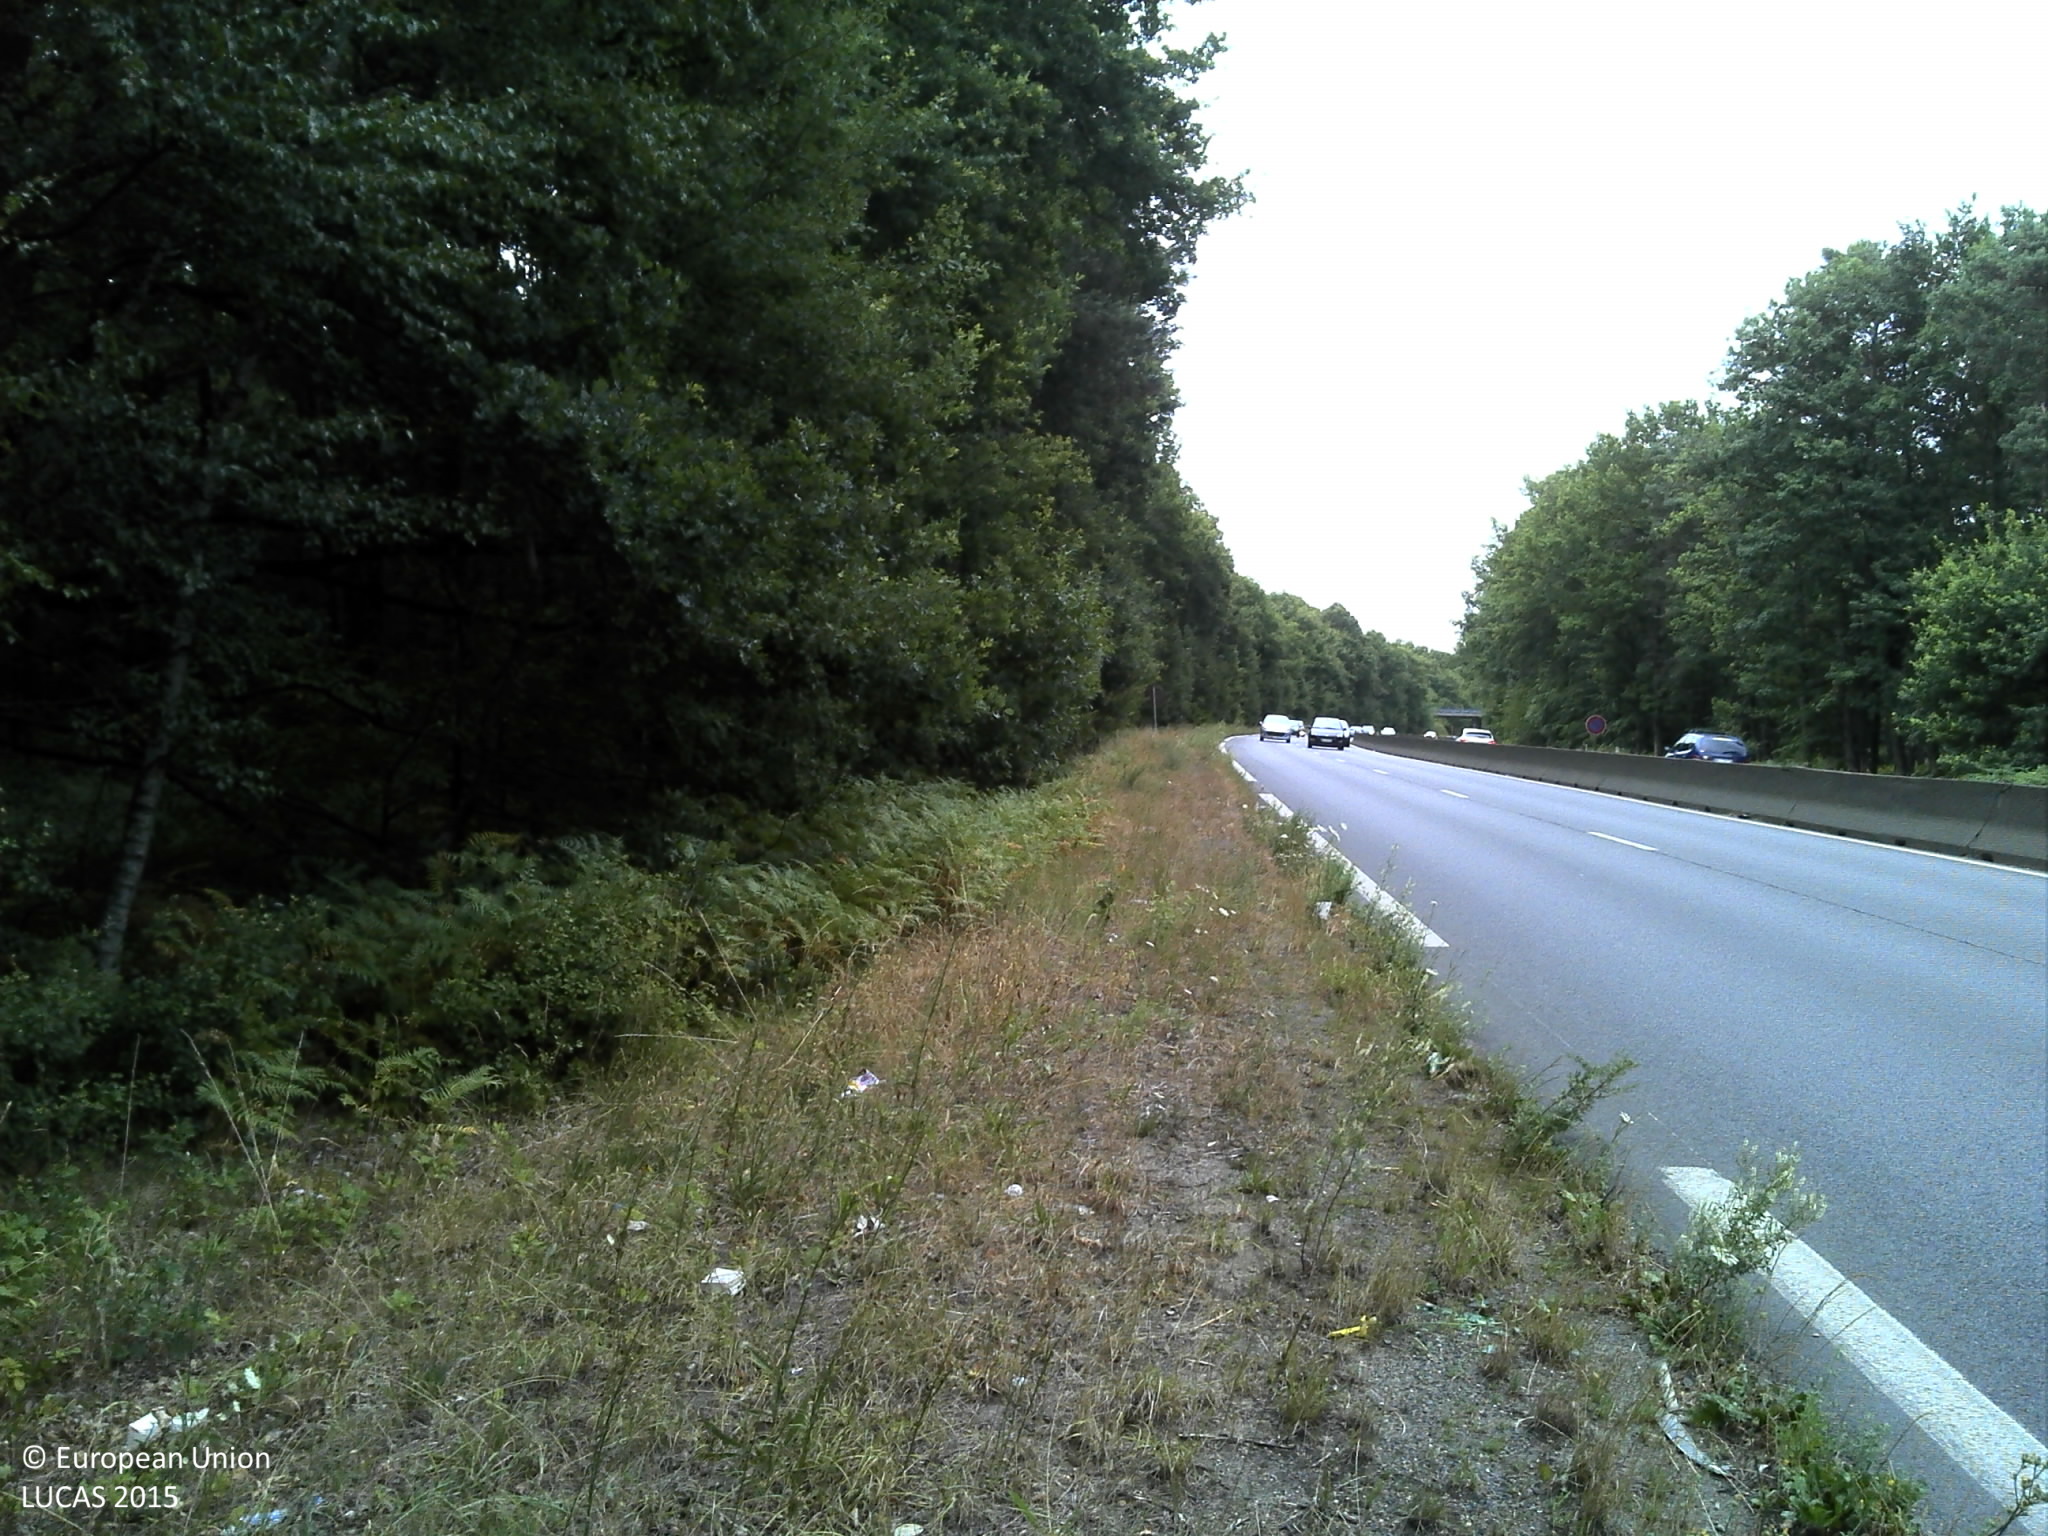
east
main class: Woodland
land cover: Pine dominated mixed woodland
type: hemiboreal forest and nemoral coniferous forest and mixed broadleaved-coniferous forest
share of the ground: > 75 %
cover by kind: broadleaved forest trees 55 %, coniferous forest trees 35 %, herbaceous plants 10 %
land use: Forestry
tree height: > 5 m
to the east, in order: Pine dominated mixed woodland; Grass margins; Paved roads, cycling and walking lanes; Grass margins
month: July
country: FR
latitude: 48.6891
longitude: 2.4768
